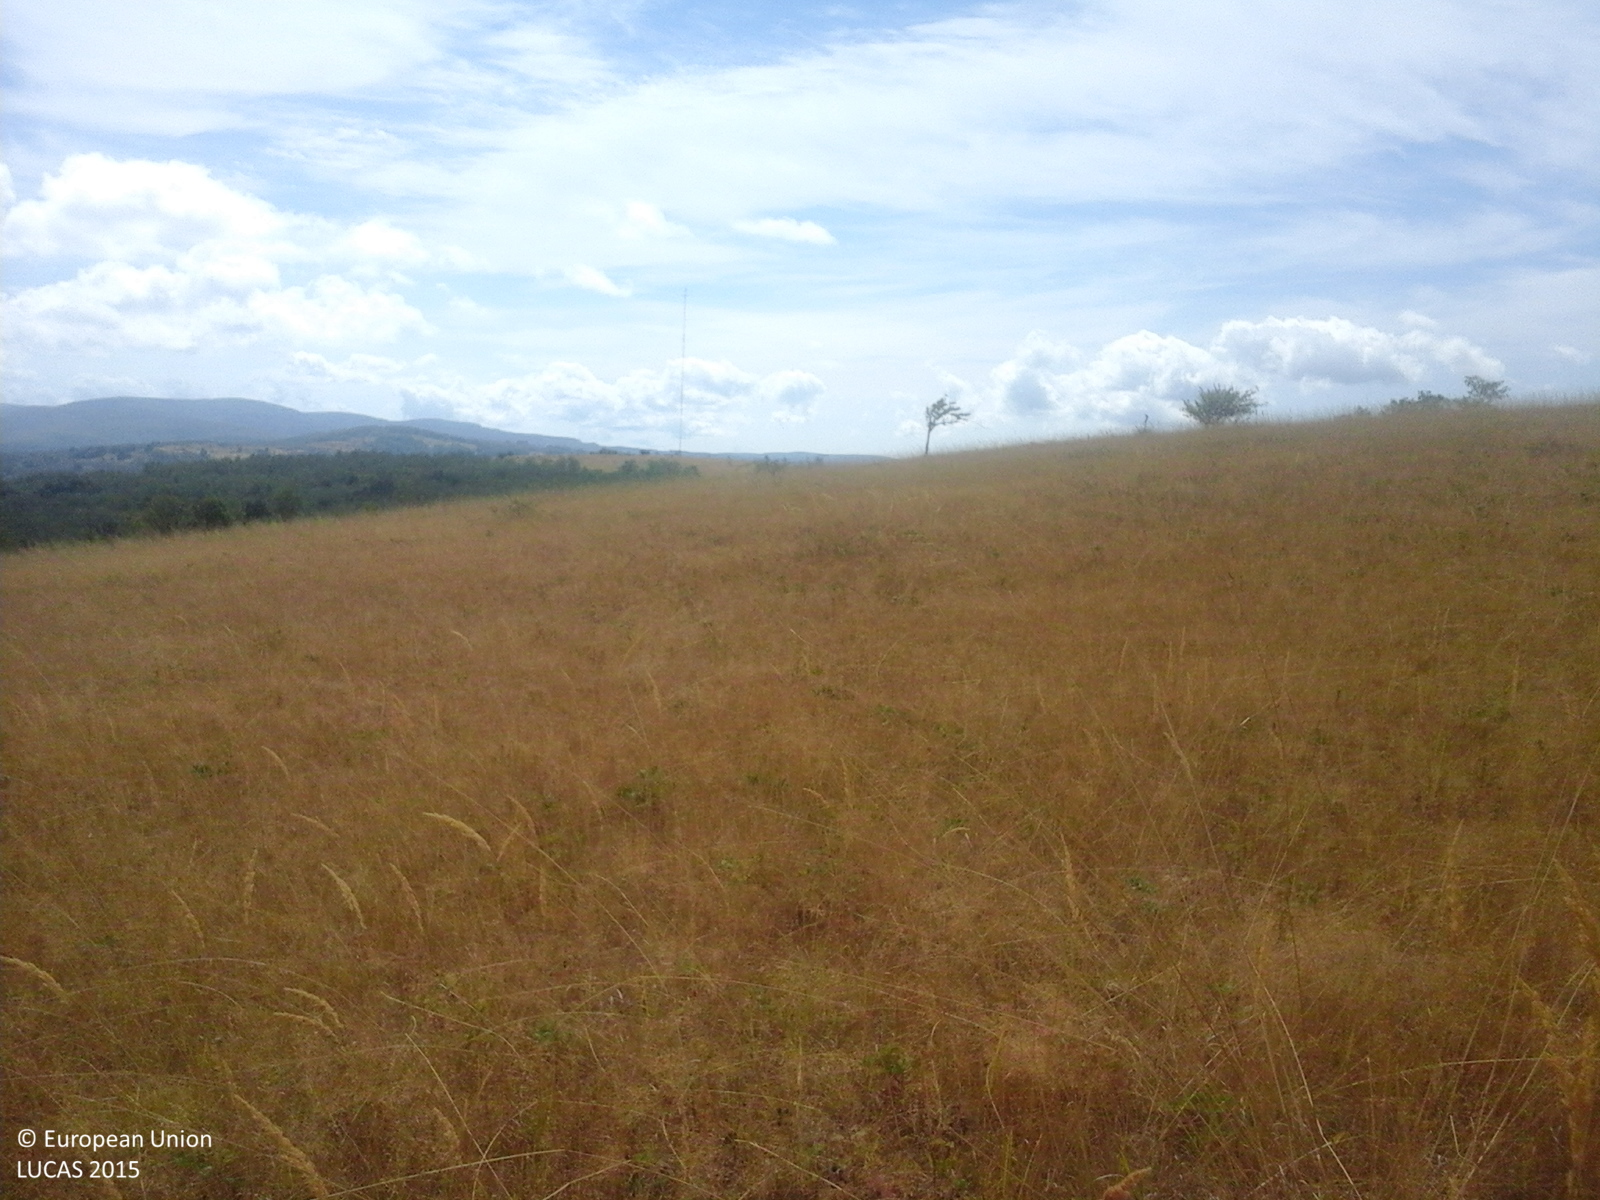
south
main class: Grassland
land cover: Grassland without tree/shrub cover
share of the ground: > 75 %
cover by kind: herbaceous plants 100 %
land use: Agriculture (excluding fallow land and kitchen gardens)
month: August
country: RO
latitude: 44.9121
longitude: 21.6455
